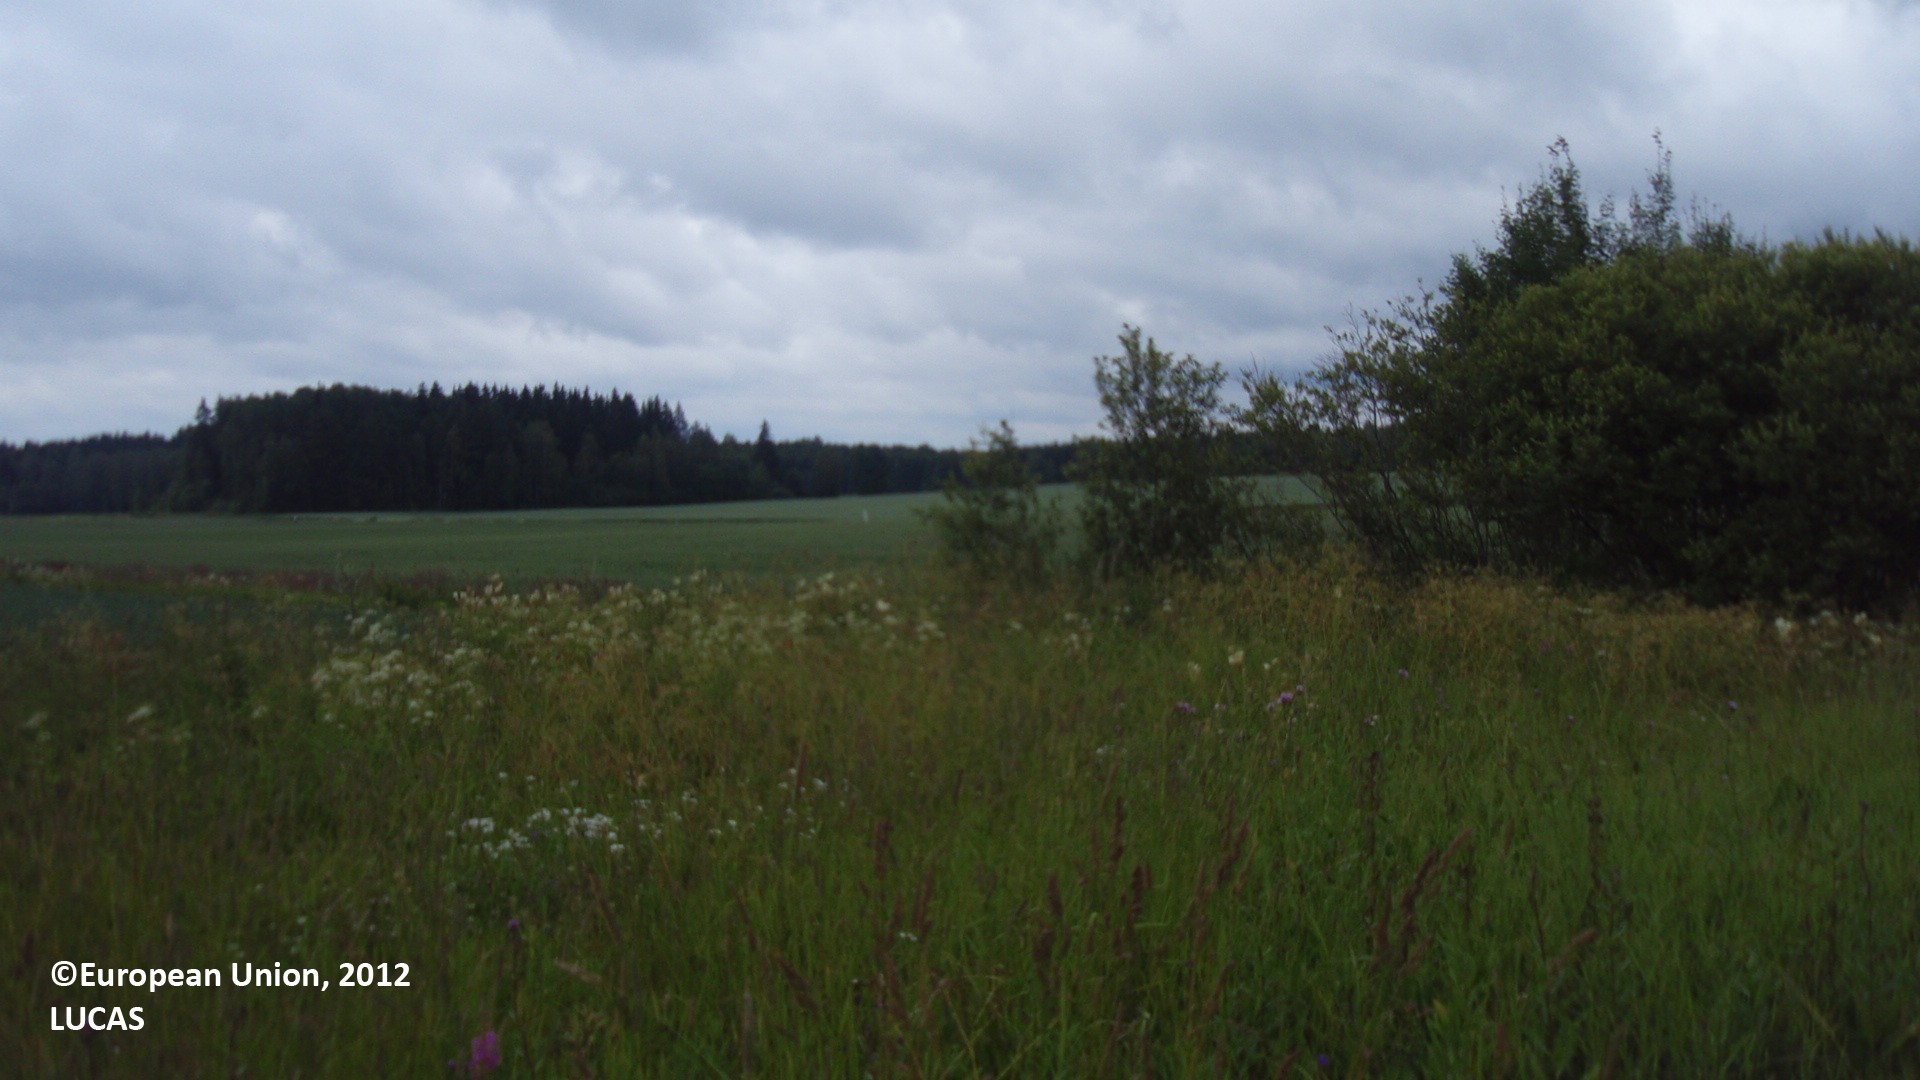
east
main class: Grassland
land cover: Grassland without tree/shrub cover
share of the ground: > 75 %
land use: Fallow land
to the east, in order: Grassland without tree/shrub cover; Oats; Grass margins; Ditches and canals; Grass margins; Oats
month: July
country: FI
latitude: 61.0923
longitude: 28.5202
